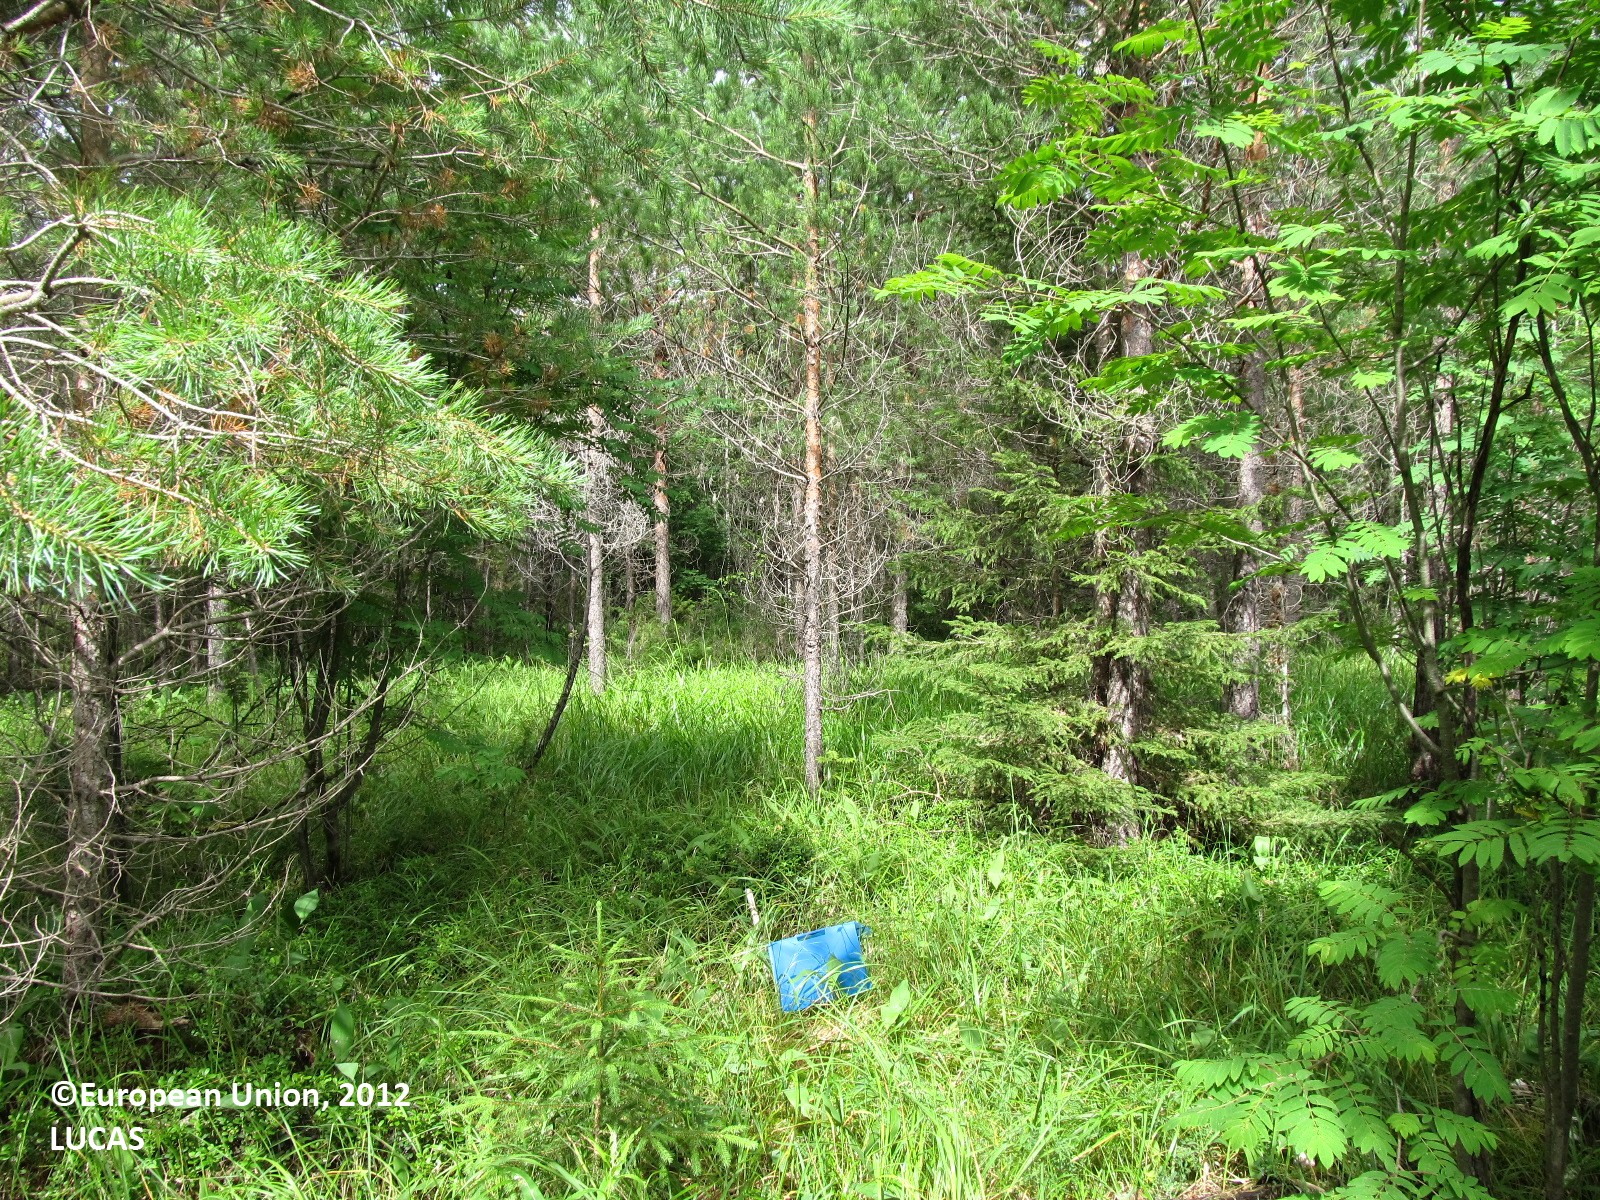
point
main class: Woodland
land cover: Pine dominated coniferous woodland
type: boreal forest
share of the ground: 25 - 50 %
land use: Forestry
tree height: > 5 m
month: July
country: FI
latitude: 61.9382
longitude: 29.0349
